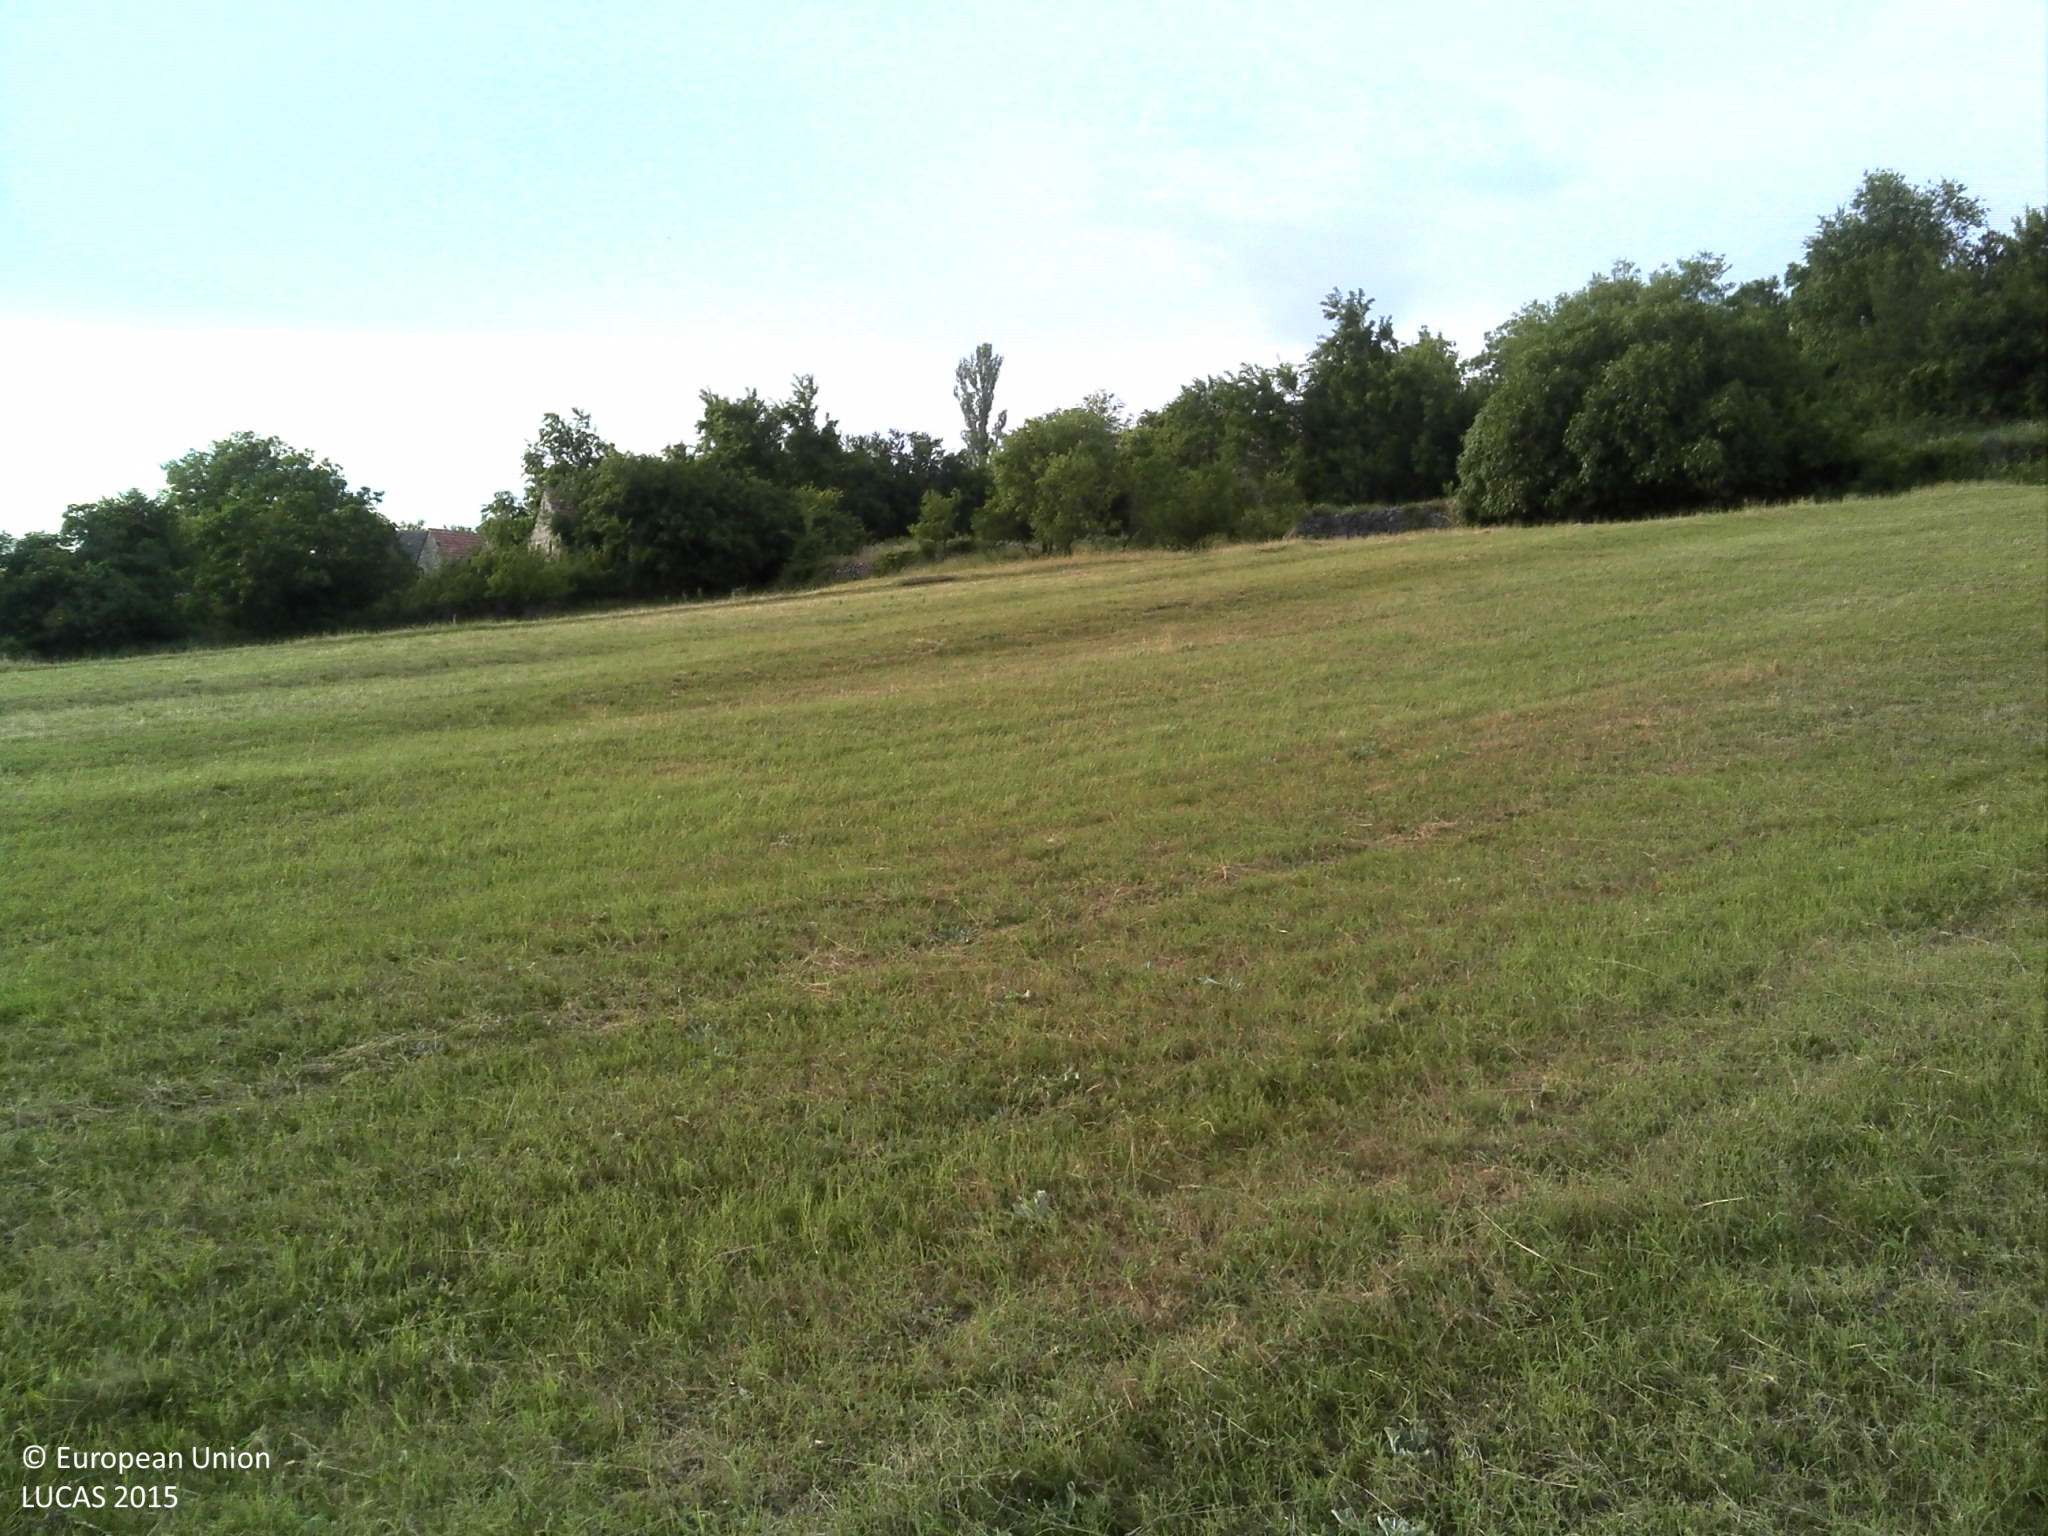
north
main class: Grassland
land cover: Grassland with sparse tree/shrub cover
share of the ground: > 75 %
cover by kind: herbaceous plants 90 %, broadleaved forest trees 5 %, shrubs 5 %
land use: Agriculture (excluding fallow land and kitchen gardens)
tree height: < 5 m
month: June
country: HR
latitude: 43.8948
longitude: 16.4783
